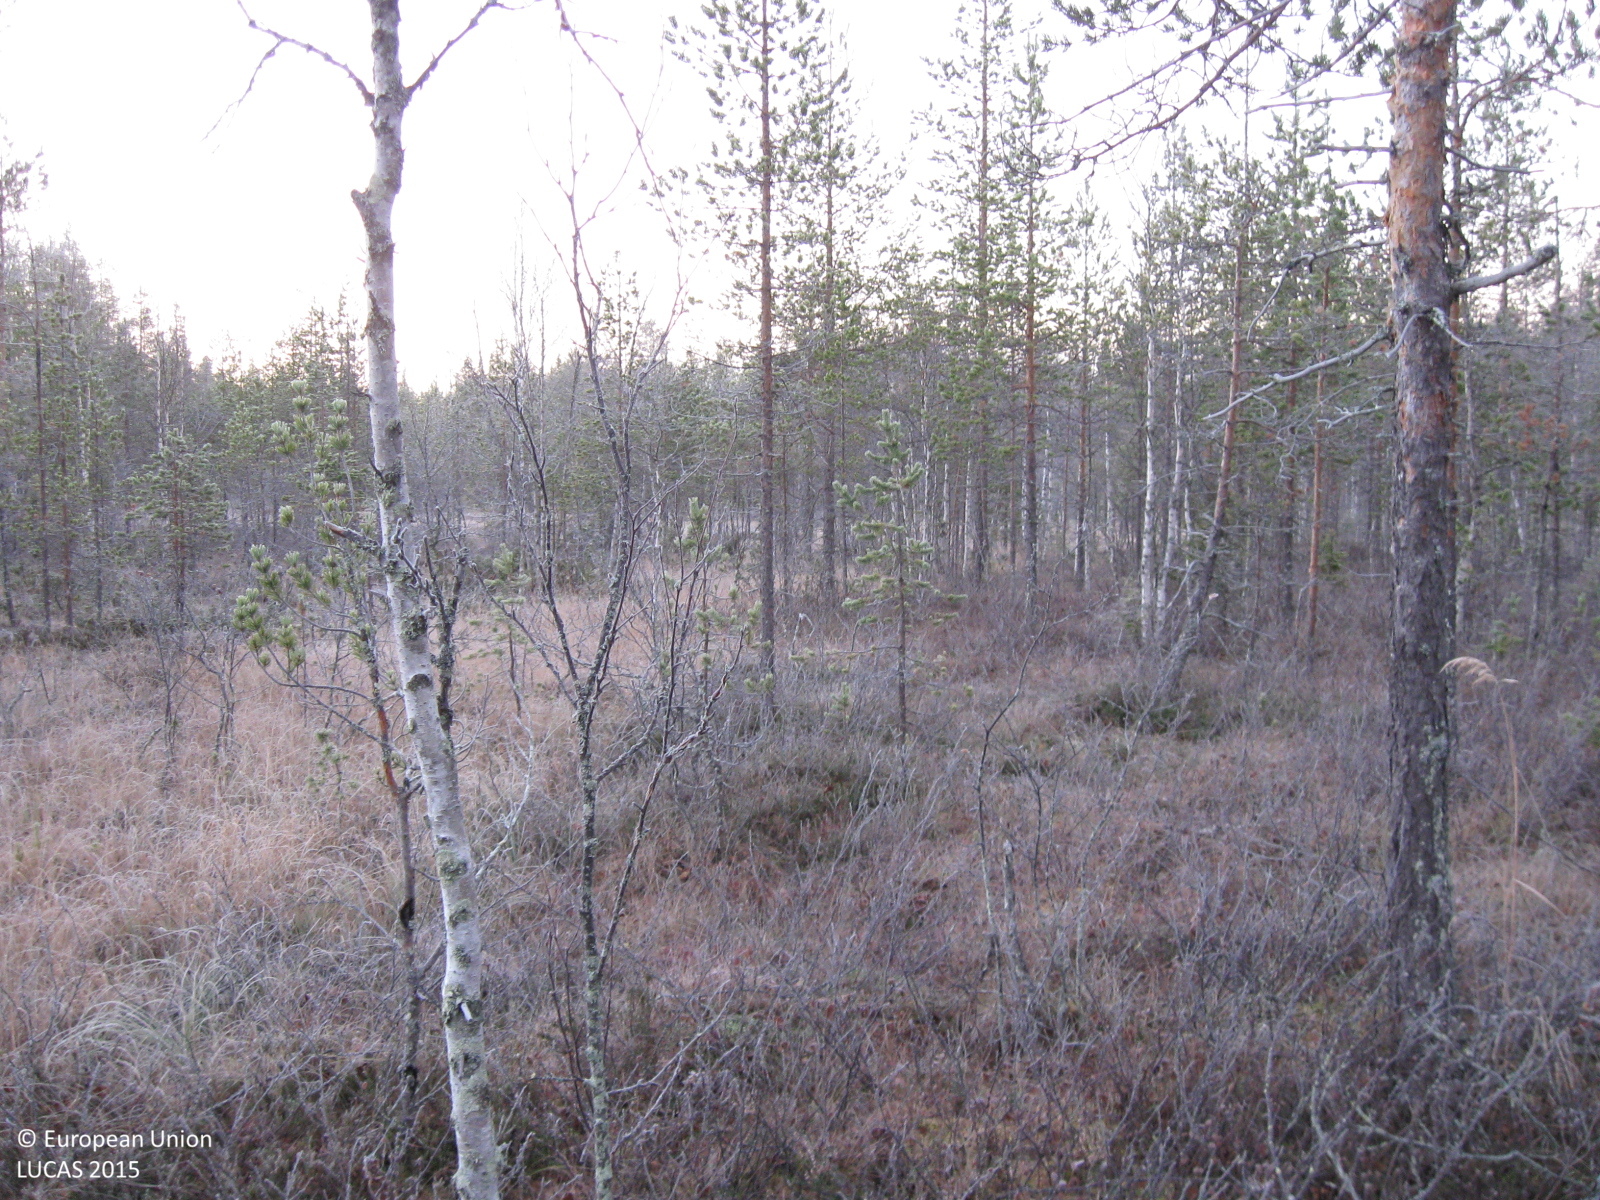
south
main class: Woodland
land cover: Pine dominated coniferous woodland
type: mire and swamp forests
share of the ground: 50 - 75 %
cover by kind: coniferous forest trees 45 %, shrubs 25 %, herbaceous plants 15 %, broadleaved forest trees 10 %, lichens and mosses 5 %
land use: Semi-natural and natural areas not in use
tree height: > 5 m
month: October
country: SE
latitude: 66.1488
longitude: 22.1397
